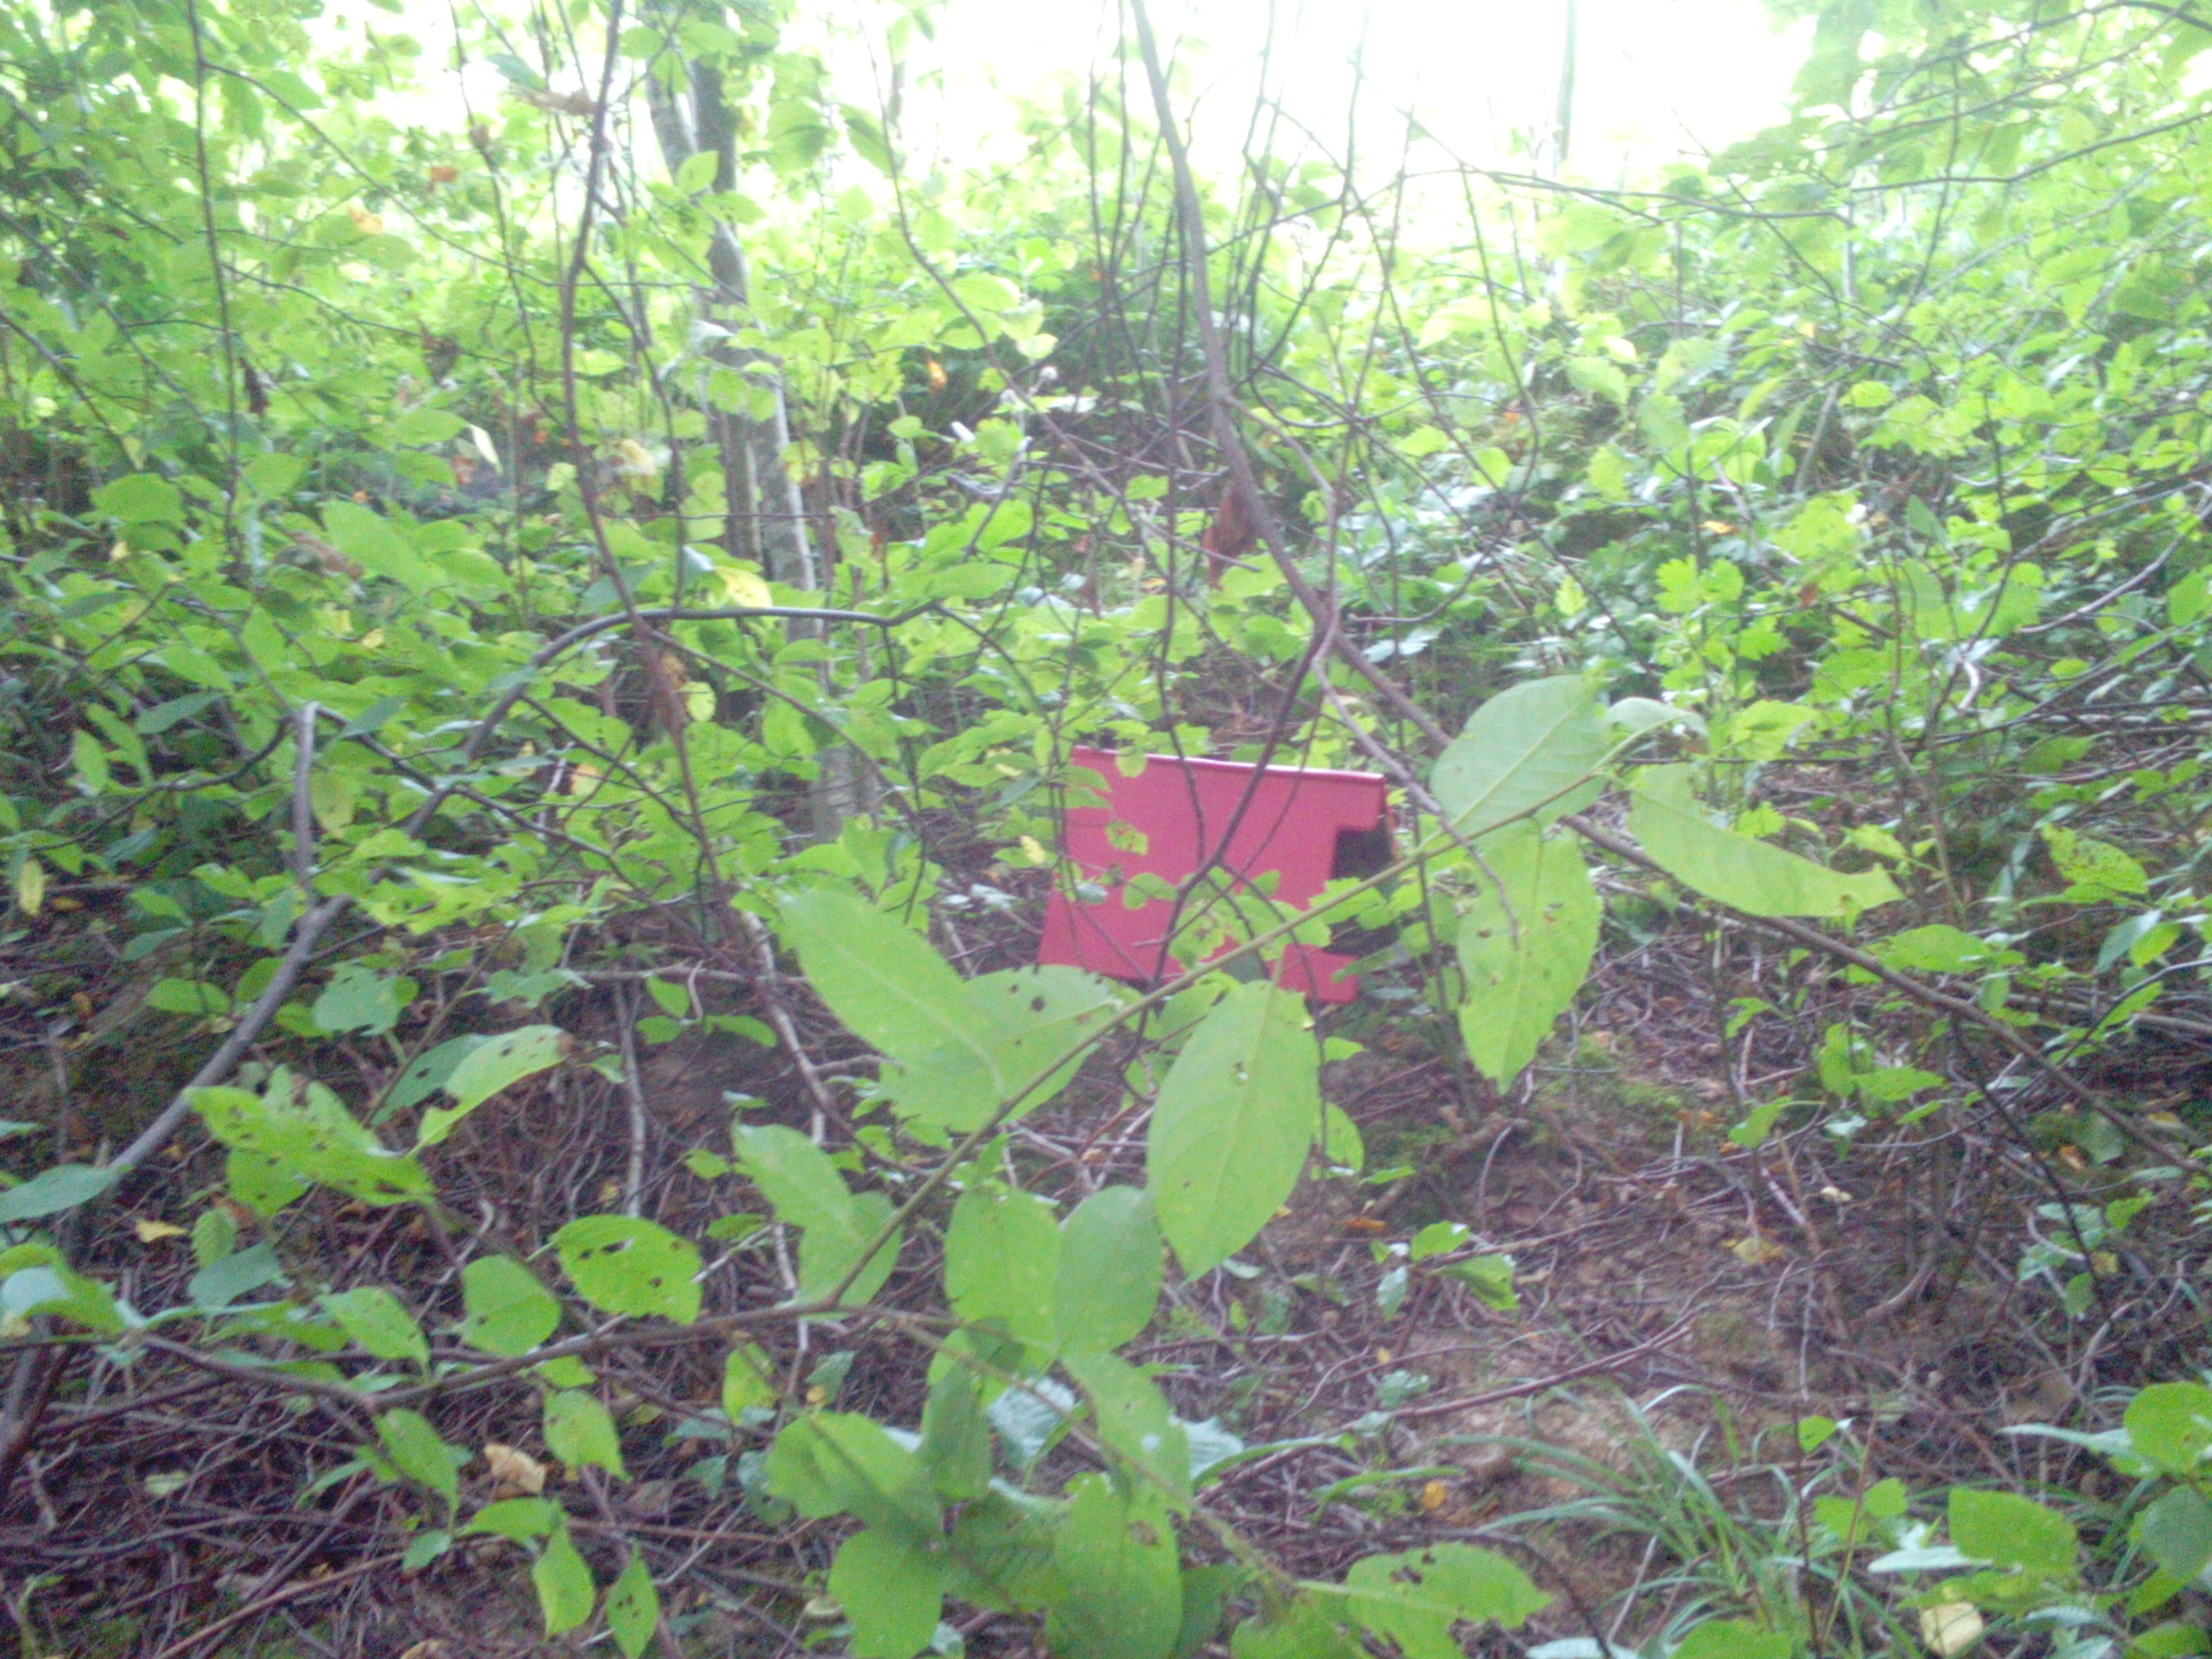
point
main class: Woodland
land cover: Broadleaved woodland
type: non-riverine alder, birch or aspen forest
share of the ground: > 75 %
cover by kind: broadleaved forest trees 75 %, herbaceous plants 25 %
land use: Forestry
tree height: > 5 m
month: July
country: LV
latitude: 56.8884
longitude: 22.2802
